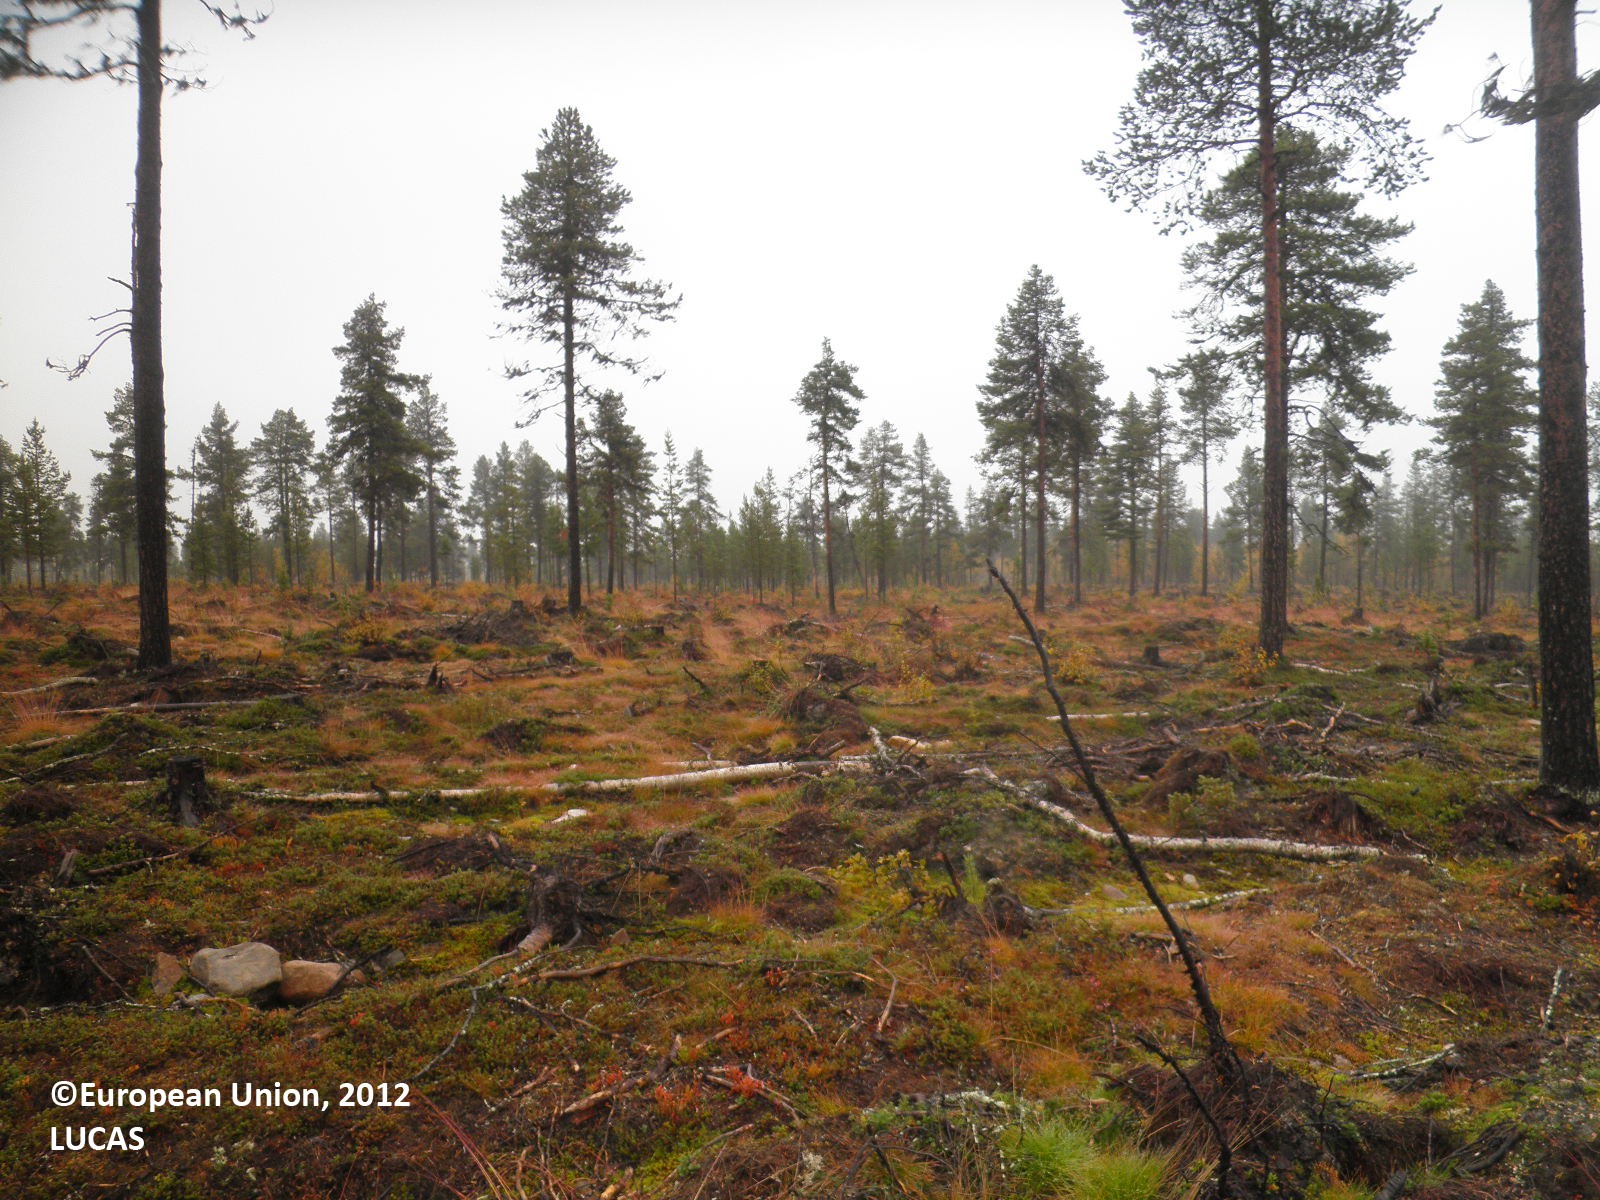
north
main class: Woodland
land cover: Pine dominated coniferous woodland
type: boreal forest
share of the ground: 10 - 25 %
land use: Forestry
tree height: > 5 m
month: September
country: FI
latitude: 68.4387
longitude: 22.7965
